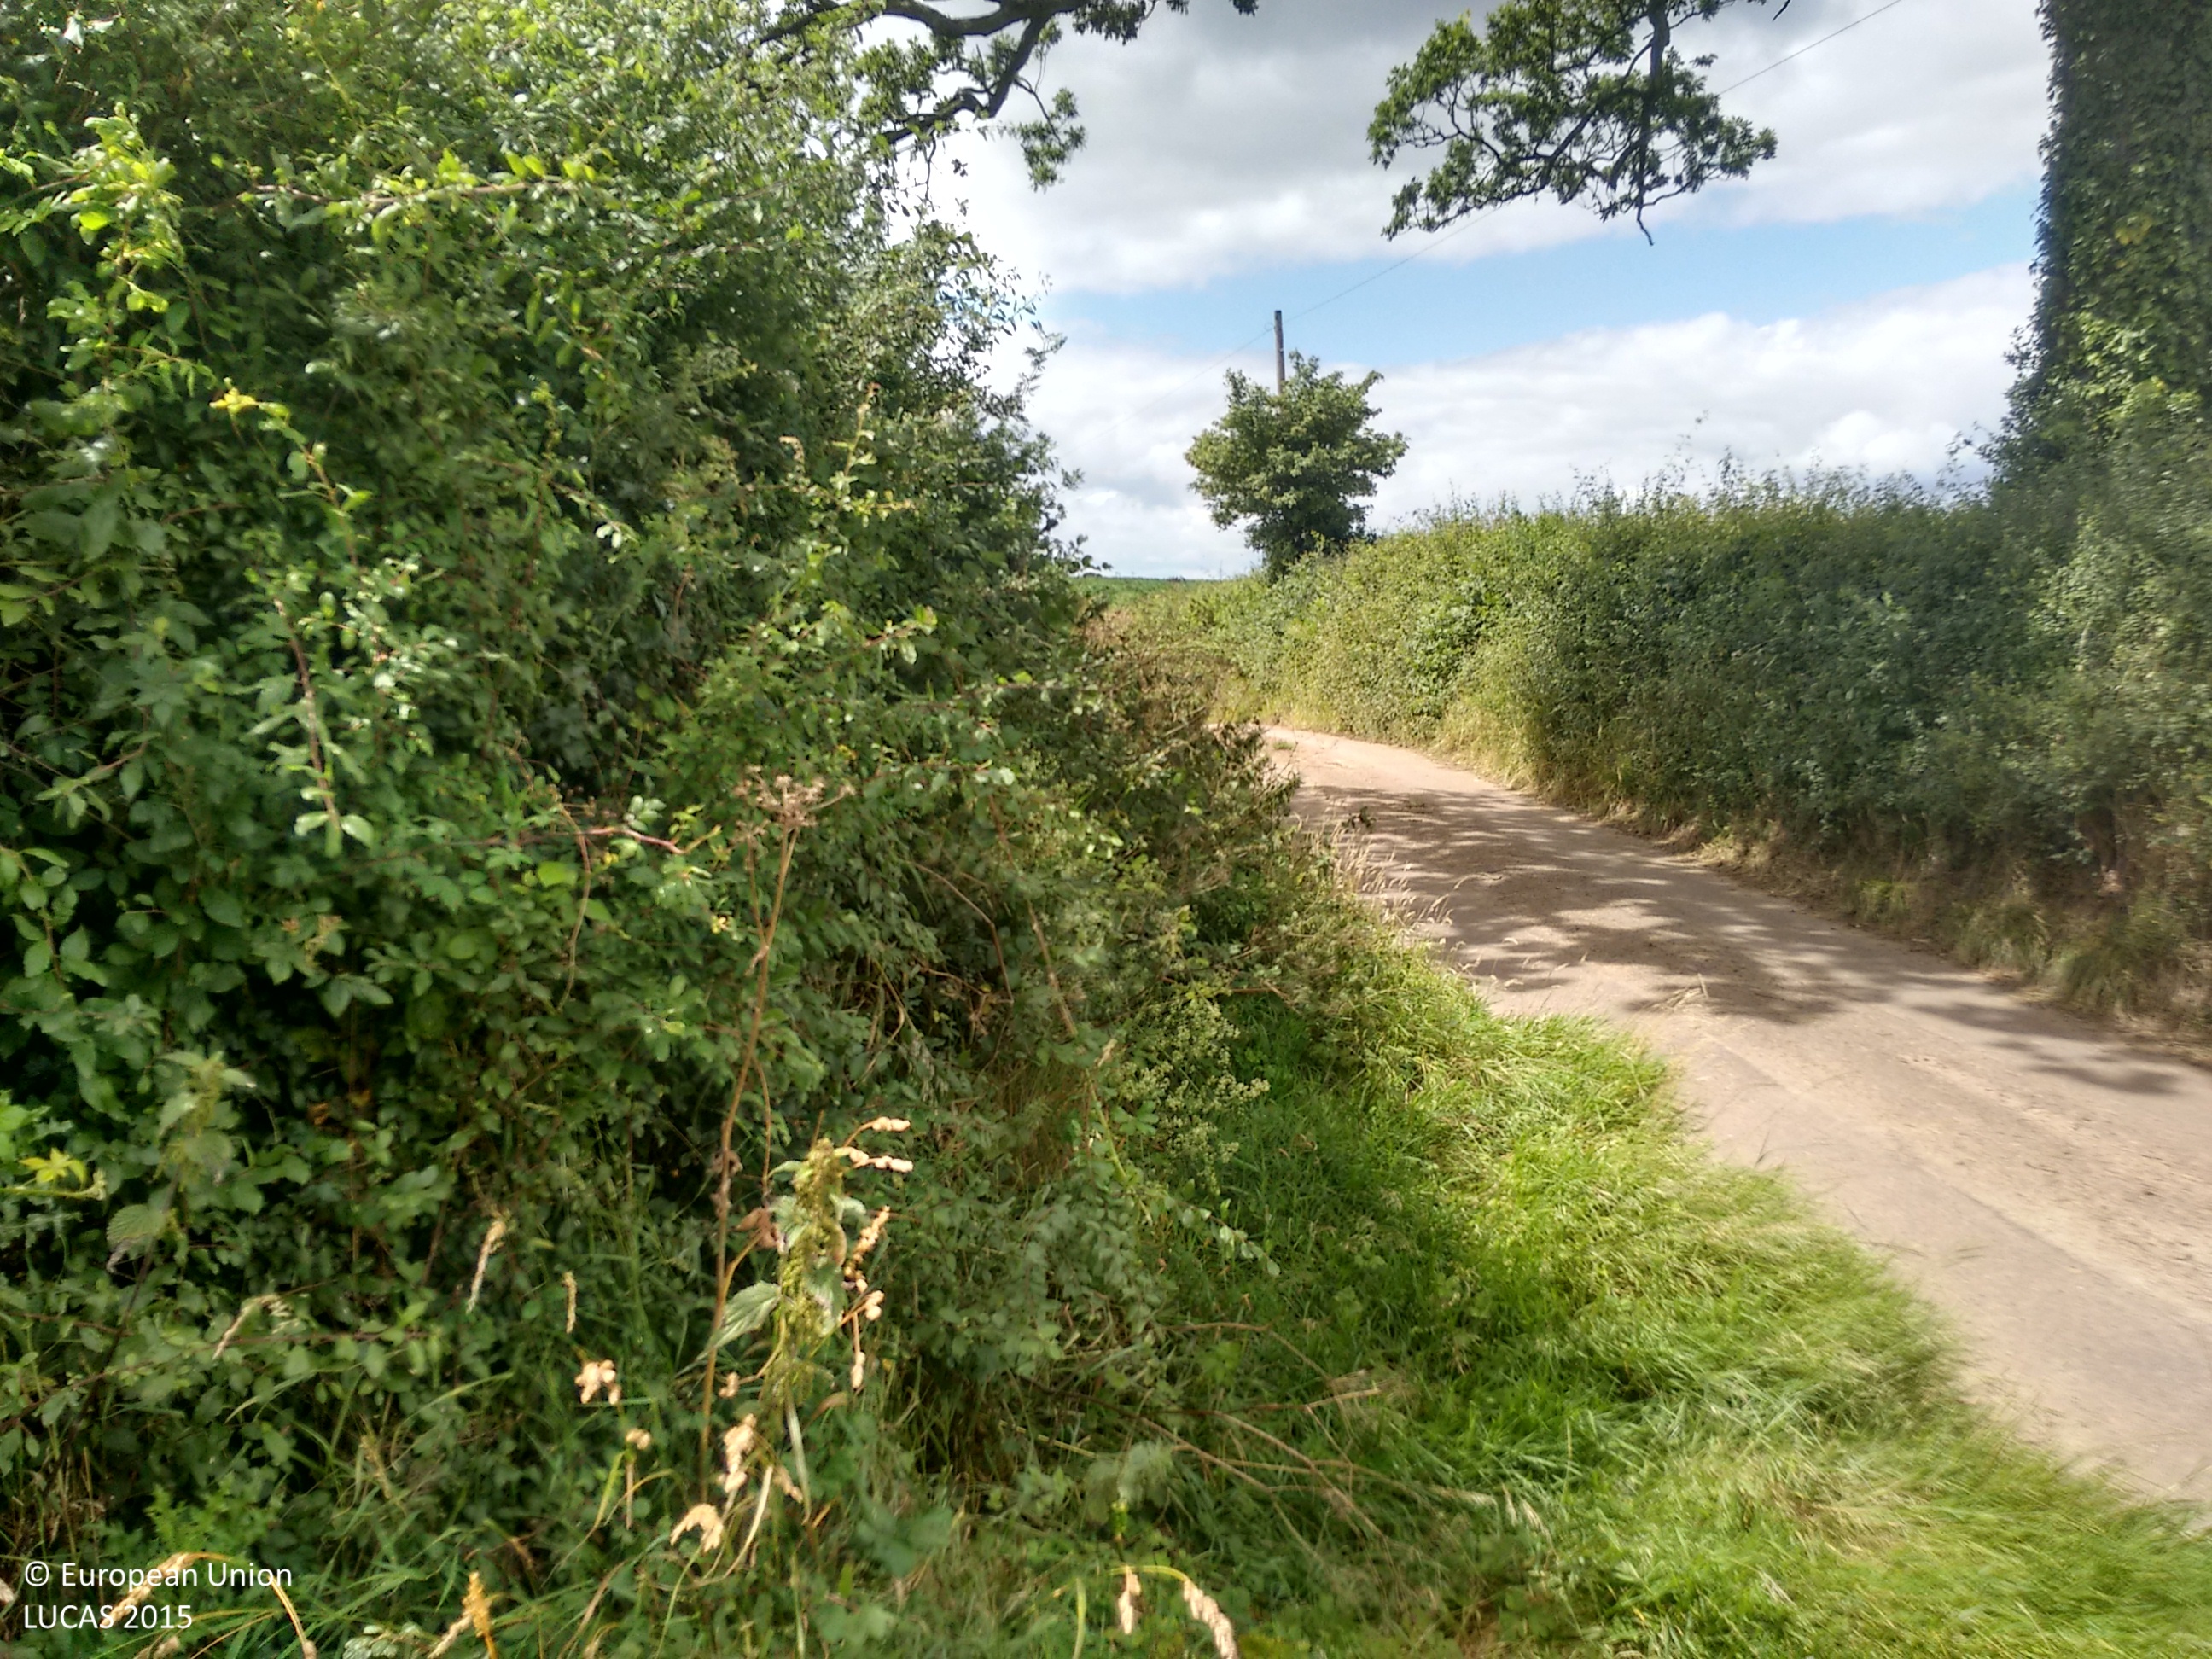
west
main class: Grassland
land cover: Grassland without tree/shrub cover
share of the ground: > 75 %
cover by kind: herbaceous plants 100 %
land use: Agriculture (excluding fallow land and kitchen gardens)
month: July
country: GB
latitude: 50.6656
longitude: -3.3951
